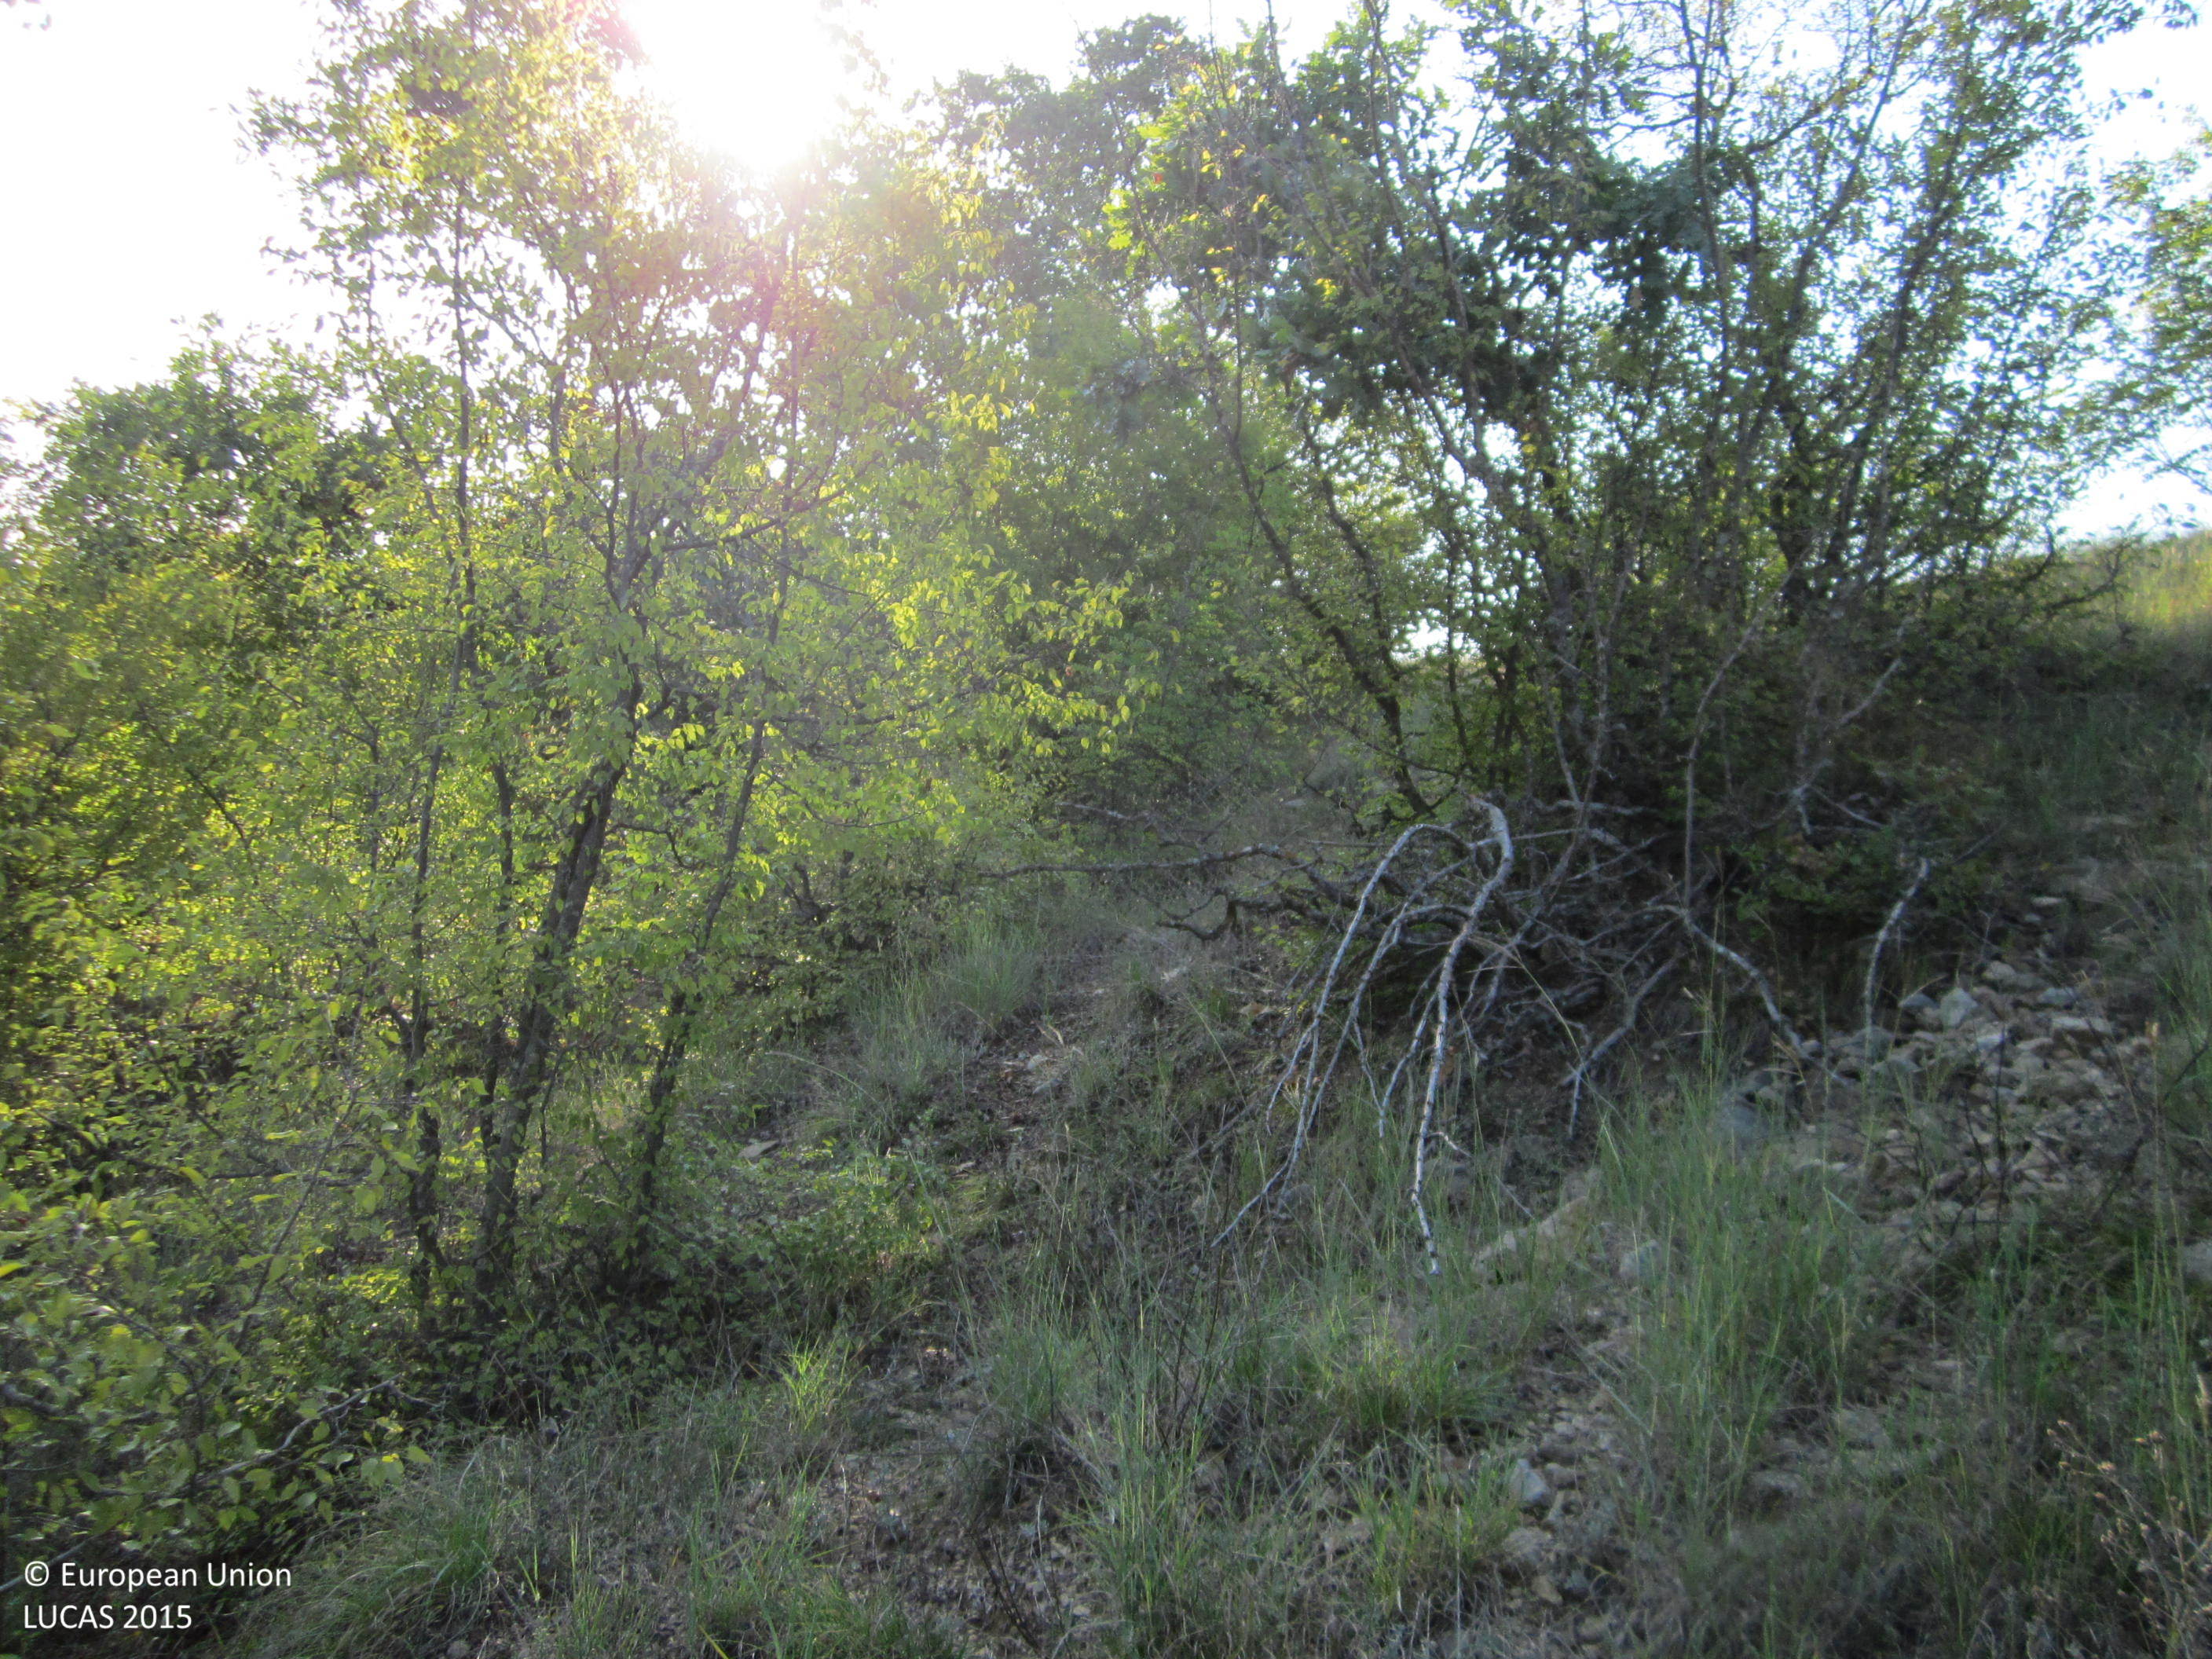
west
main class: Woodland
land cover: Broadleaved woodland
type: mesophytic deciduous forest
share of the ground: > 75 %
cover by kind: broadleaved forest trees 100 %
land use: Forestry
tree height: > 5 m
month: September
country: BG
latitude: 42.9011
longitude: 27.1999
